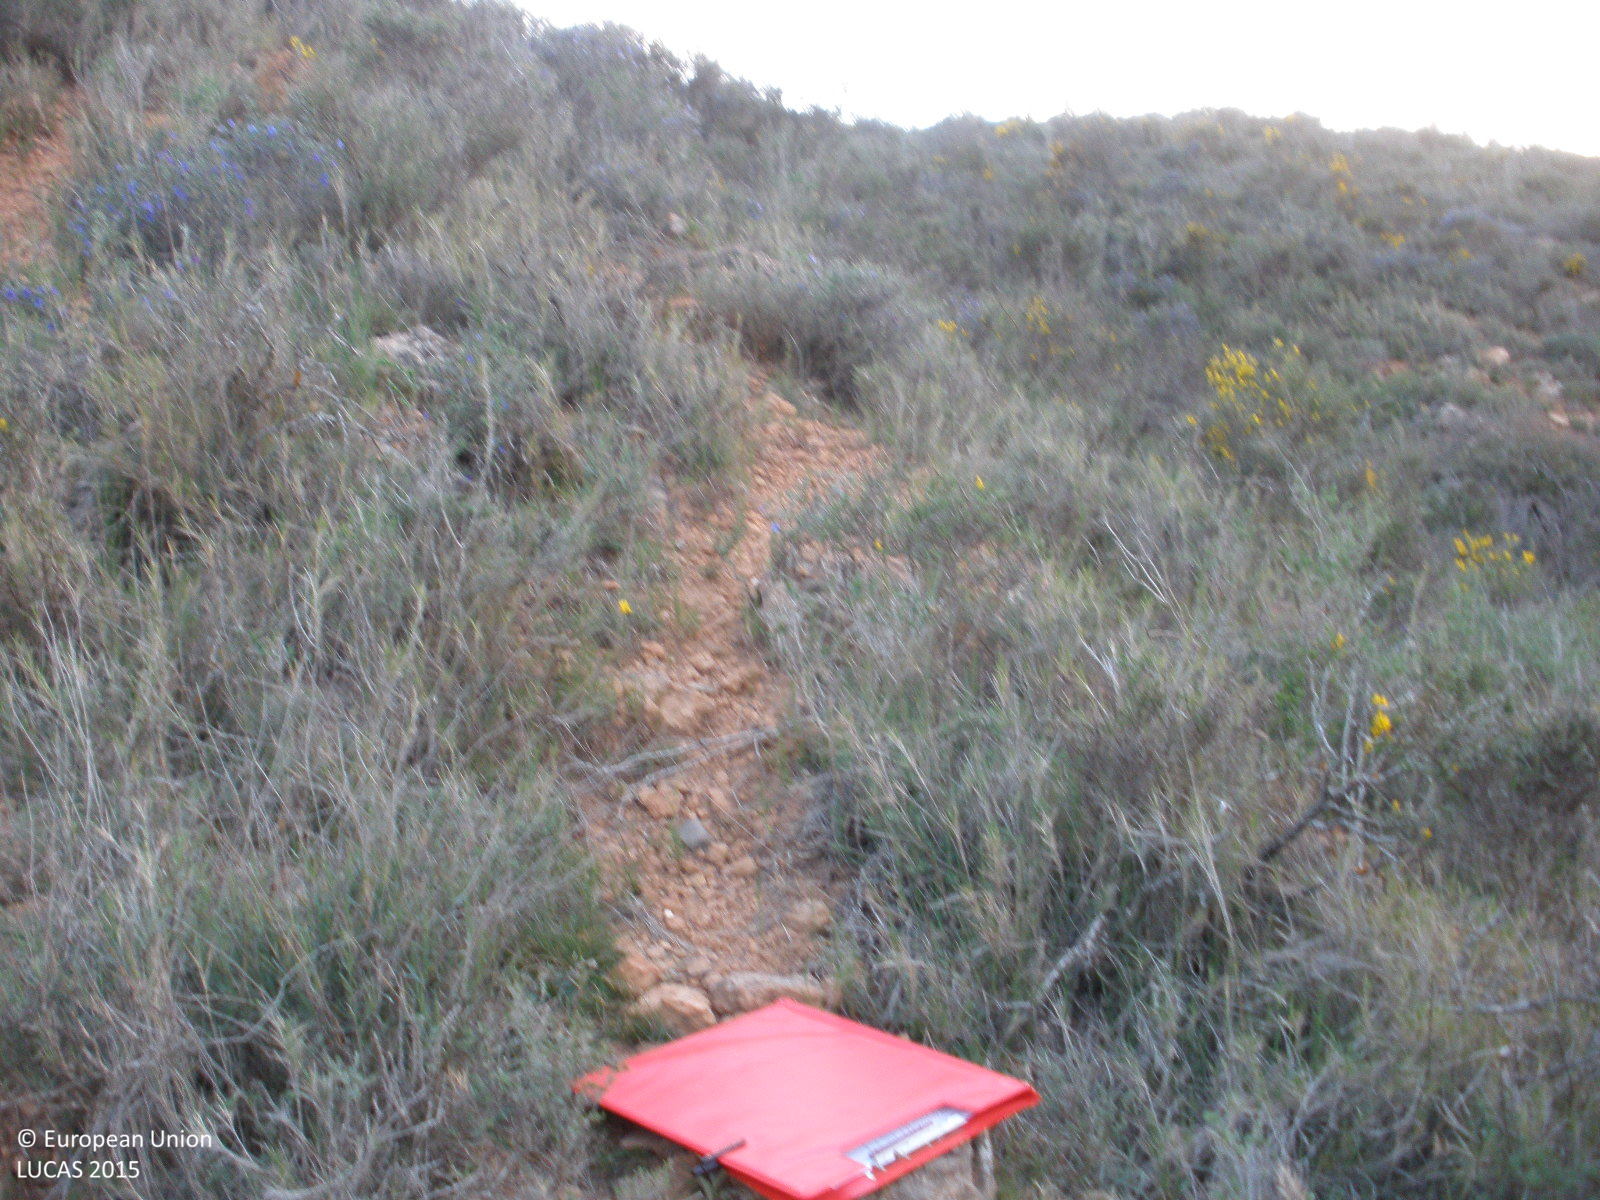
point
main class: Shrubland
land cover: Shrubland without tree cover
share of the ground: > 75 %
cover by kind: shrubs 90 %, herbaceous plants 5 %, consolidated bare surface 5 %
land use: Semi-natural and natural areas not in use
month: April
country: ES
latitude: 40.1660
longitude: -1.2466
